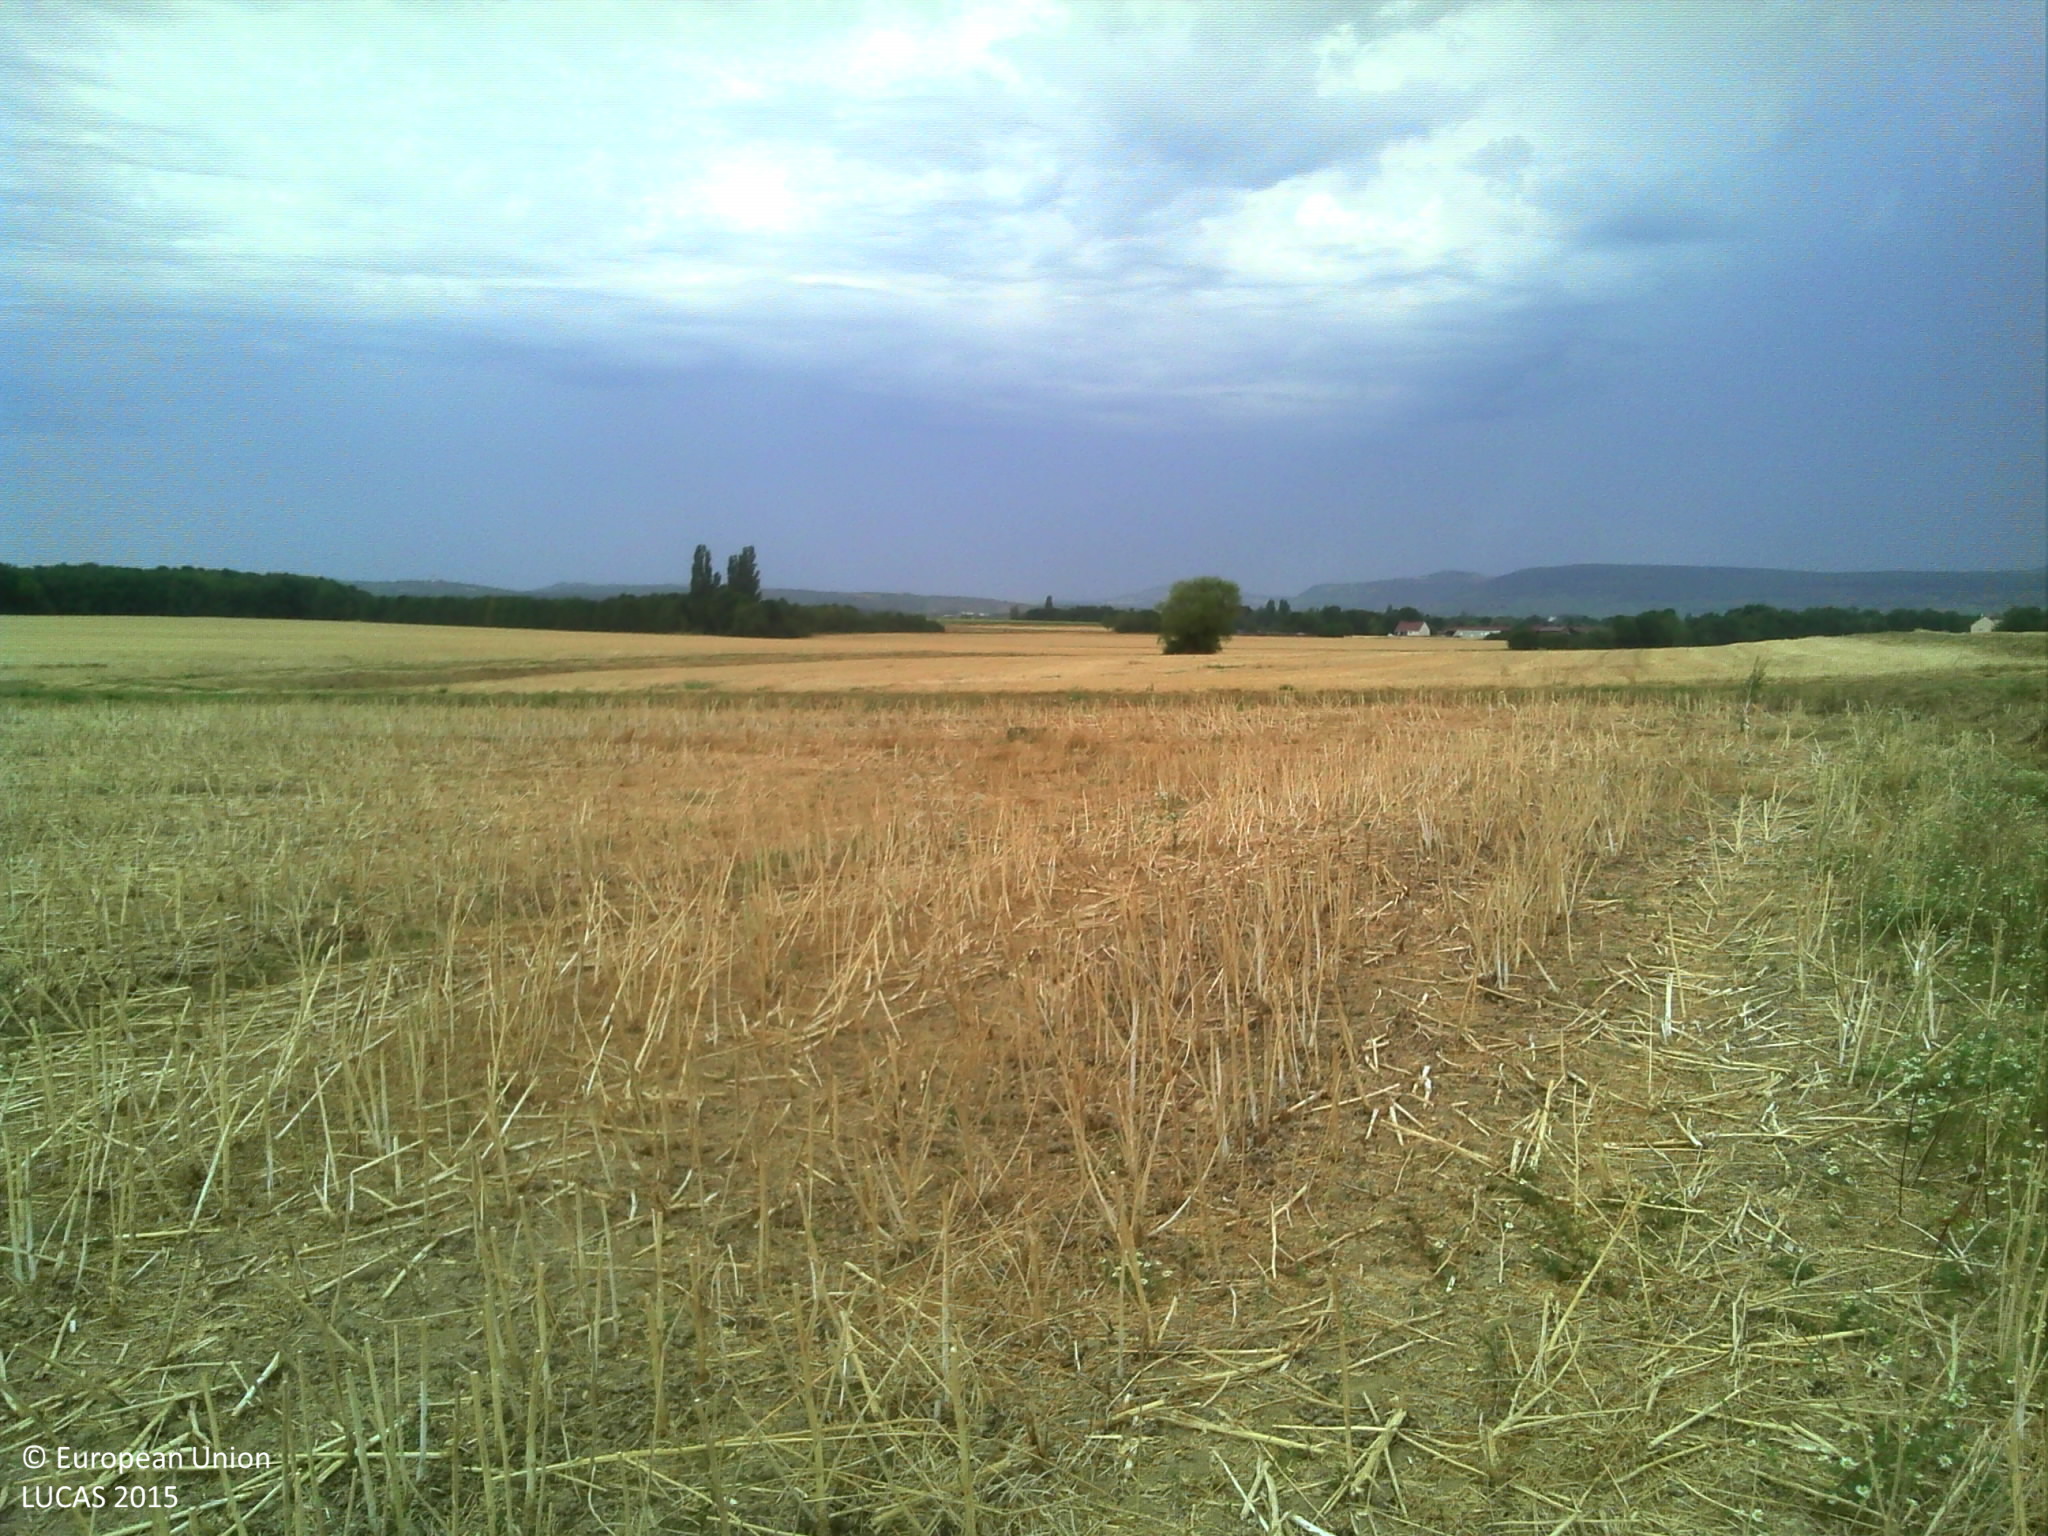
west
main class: Cropland
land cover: Rape and turnip rape
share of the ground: < 10 %
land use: Agriculture (excluding fallow land and kitchen gardens)
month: July
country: FR
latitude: 46.9112
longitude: 4.8148
